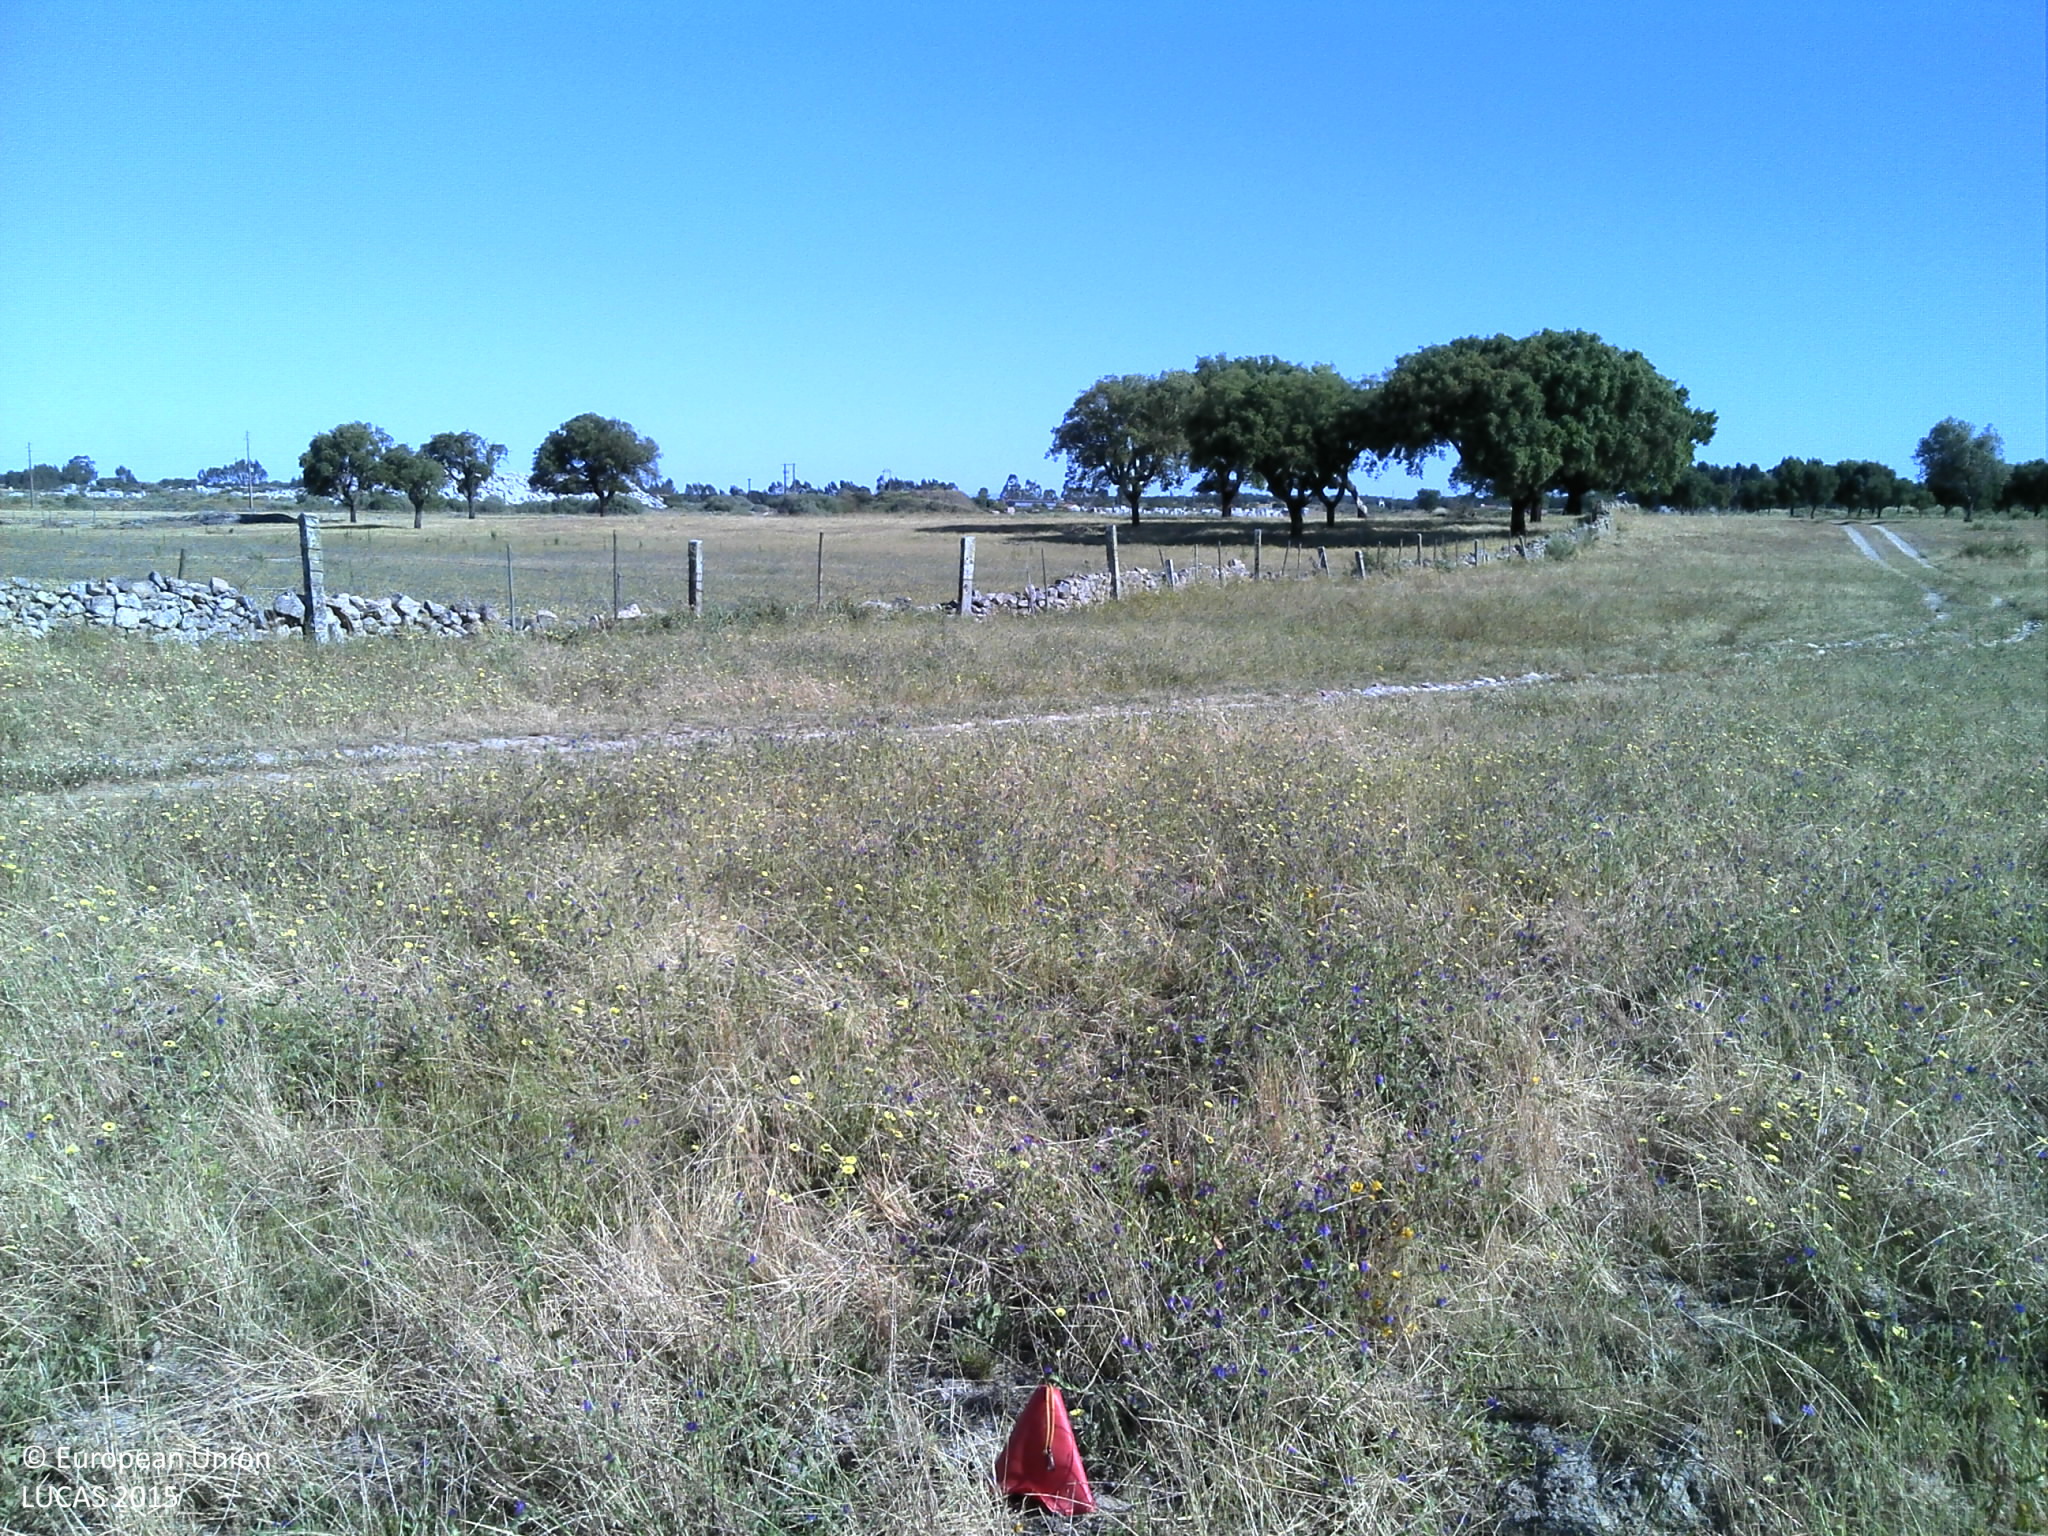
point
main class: Grassland
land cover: Grassland without tree/shrub cover
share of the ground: 50 - 75 %
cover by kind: herbaceous plants 75 %, unconsolidated bare surface 25 %
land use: Agriculture (excluding fallow land and kitchen gardens)
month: May
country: PT
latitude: 39.4328
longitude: -7.6263
